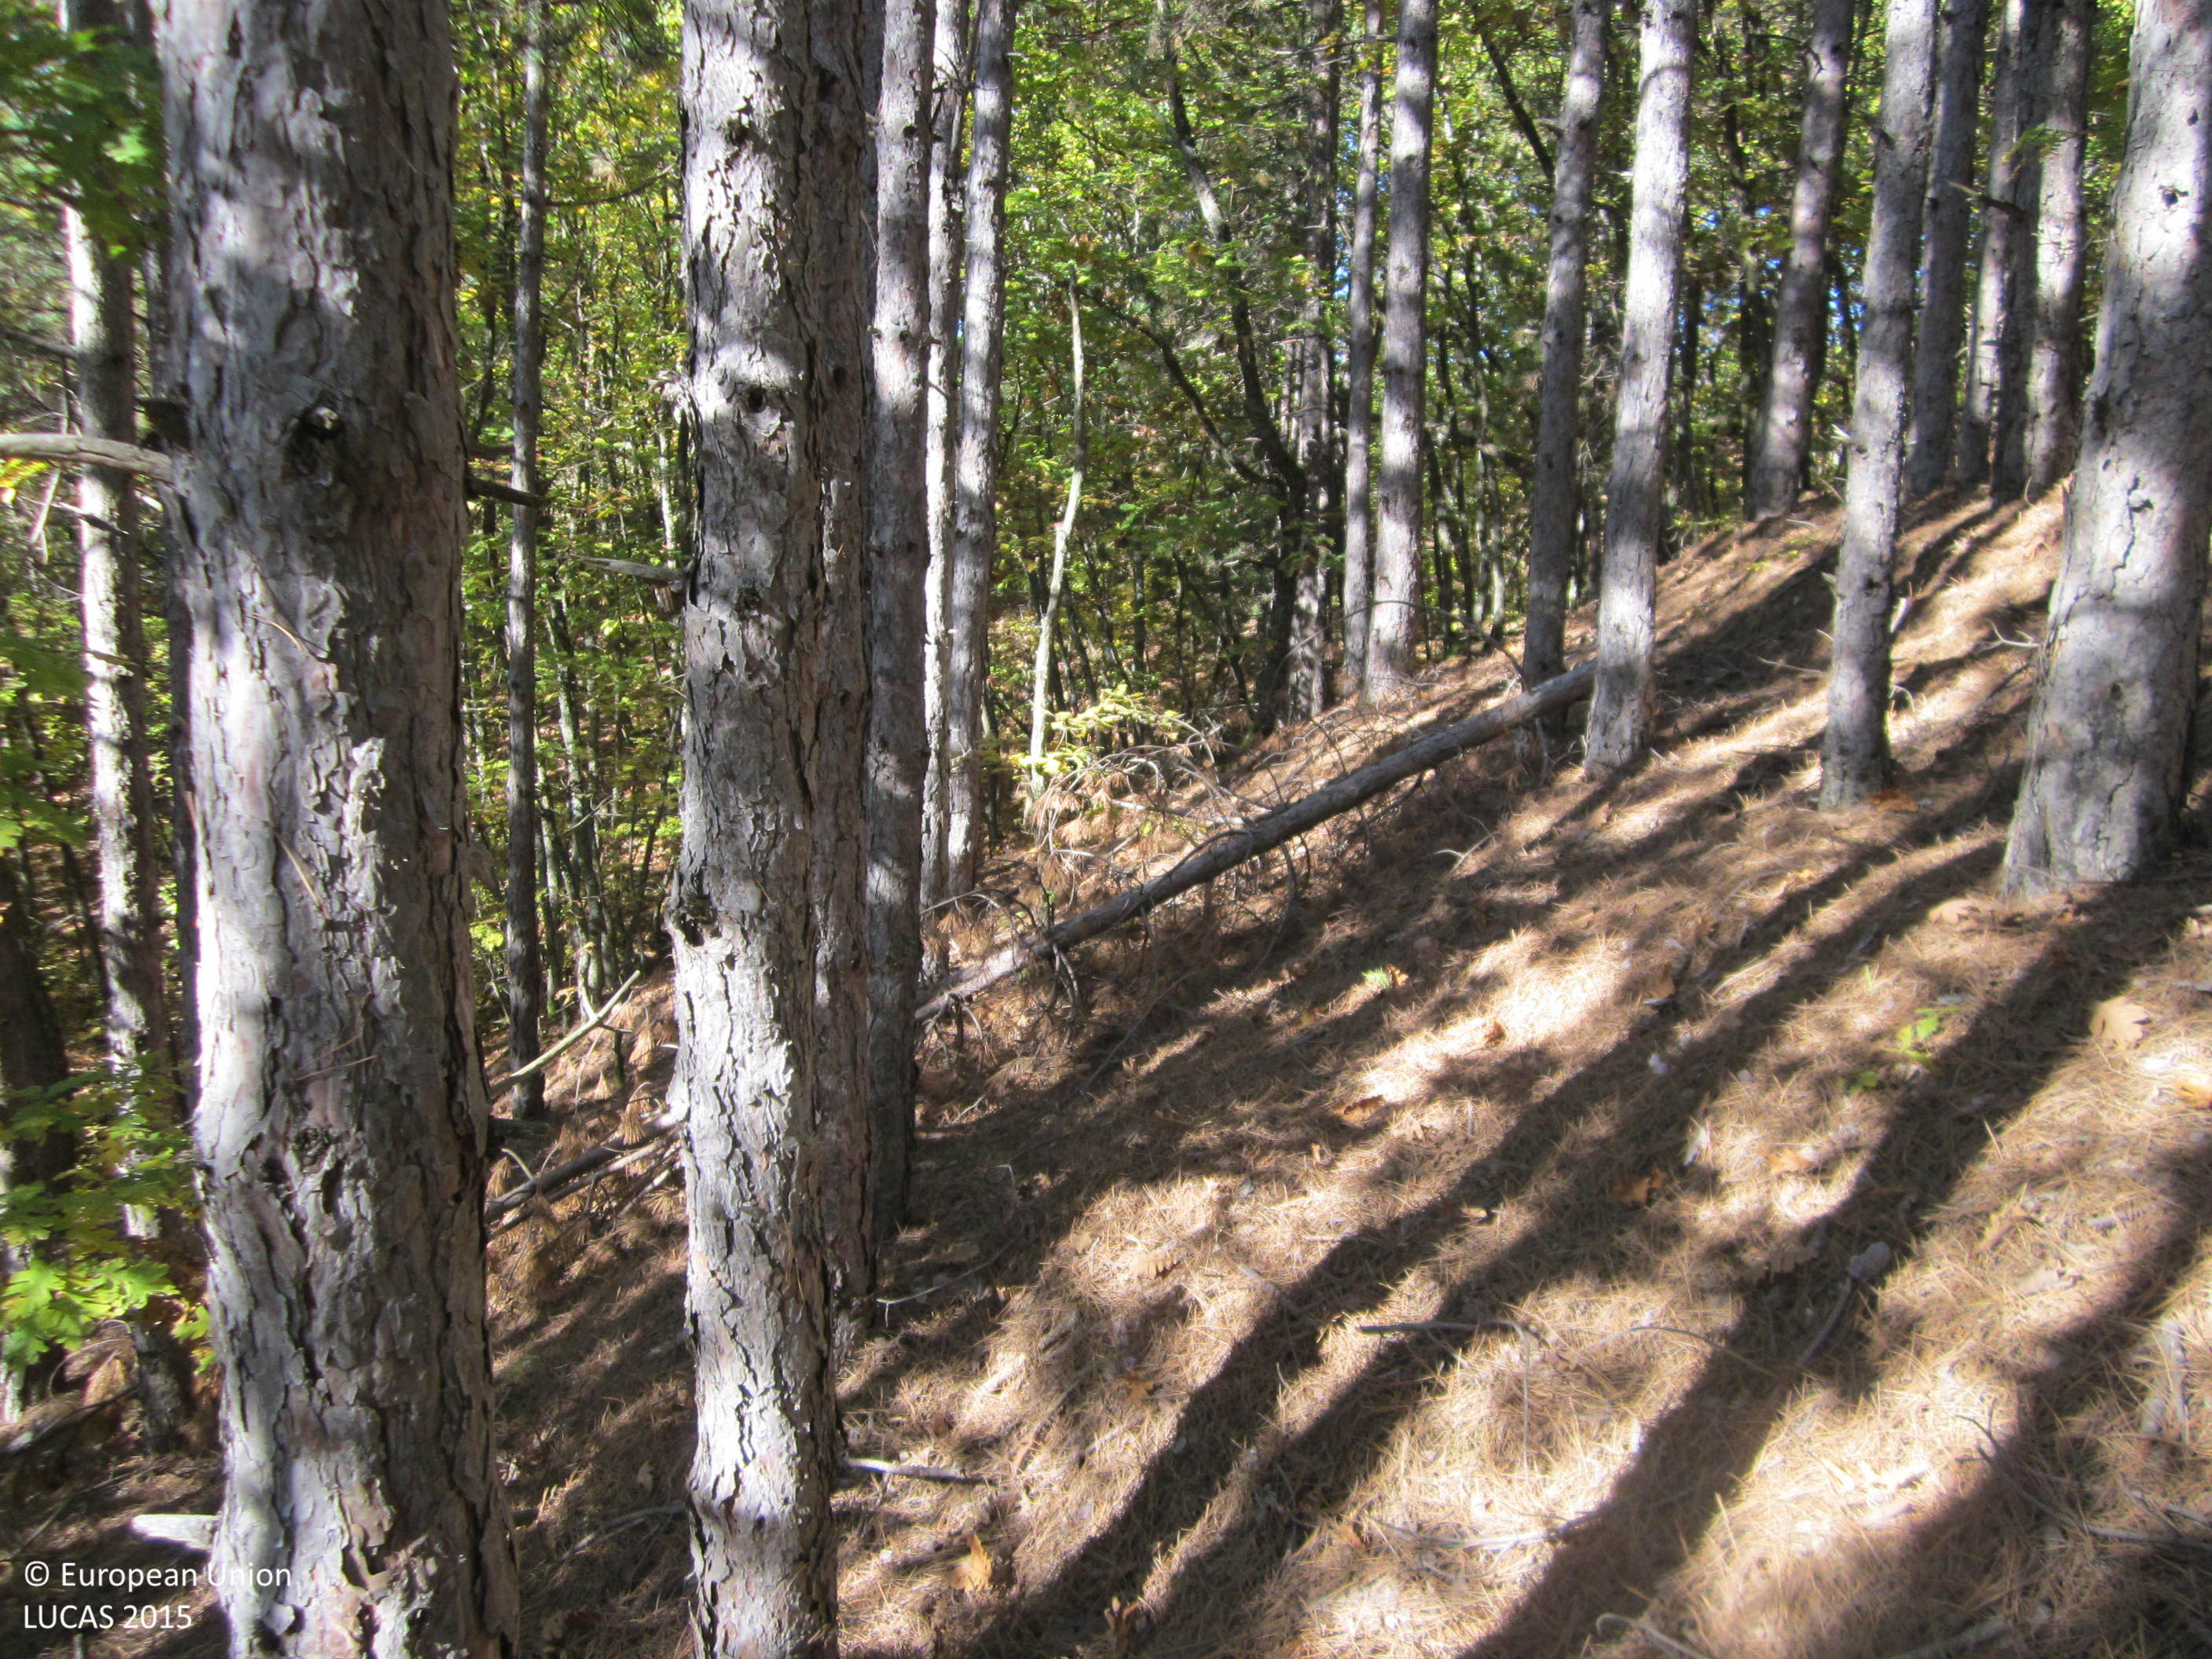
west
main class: Woodland
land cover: Pine dominated coniferous woodland
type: hemiboreal forest and nemoral coniferous forest and mixed broadleaved-coniferous forest
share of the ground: > 75 %
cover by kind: coniferous forest trees 70 %, unconsolidated bare surface 20 %, broadleaved forest trees 10 %
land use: Forestry
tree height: > 5 m
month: November
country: BG
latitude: 41.4664
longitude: 25.7593
